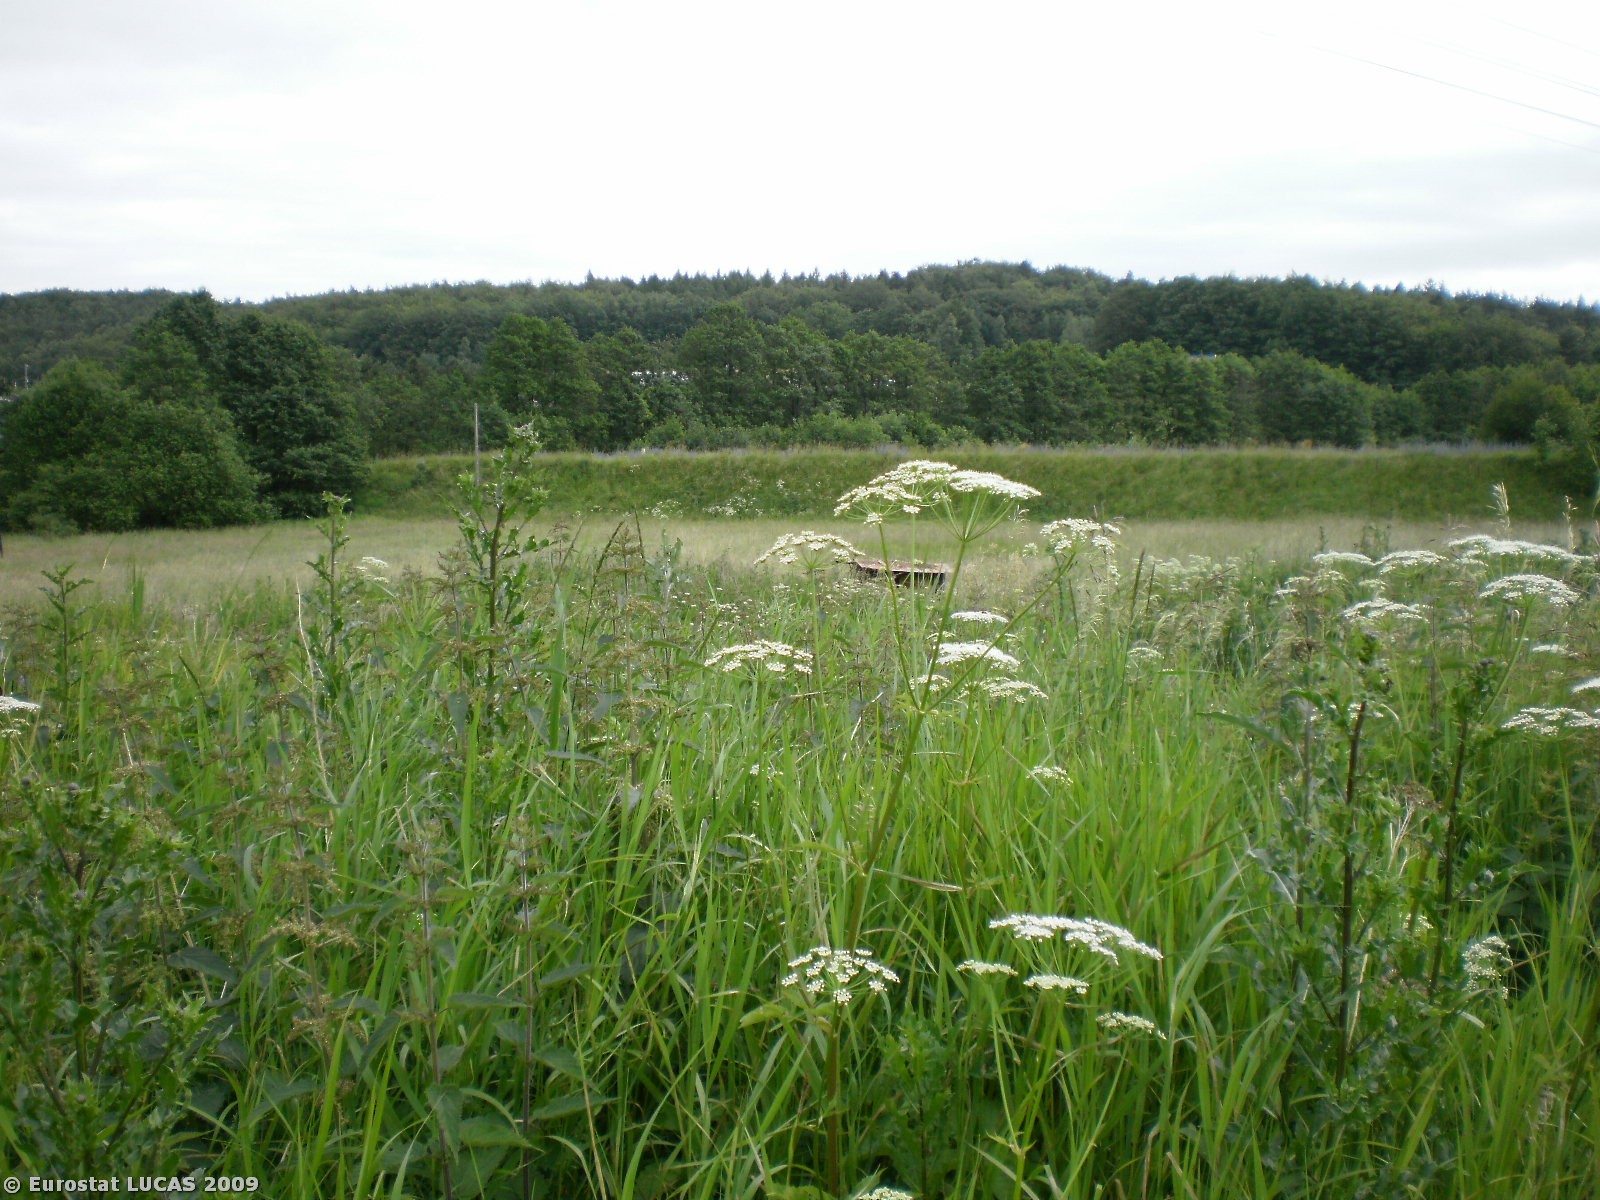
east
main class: Grassland
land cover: Grassland with sparse tree/shrub cover
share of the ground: > 75 %
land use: Unused
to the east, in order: Grassland with sparse tree/shrub cover; Tracks; Grassland without tree/shrub cover; Electric lines; Grassland without tree/shrub cover; Shrubland with sparse tree cover; Grassland without tree/shrub cover; Fences; Grass margins; Broadleaved woodland; Grass margins; Paved roads, cycling and walking lanes; Other structural elements; Paved roads, cycling and walking lanes; Grassland with sparse tree/shrub cover; Fences; Tracks; Grassland with sparse tree/shrub cover
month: June
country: PL
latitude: 54.4597
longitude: 18.4858
